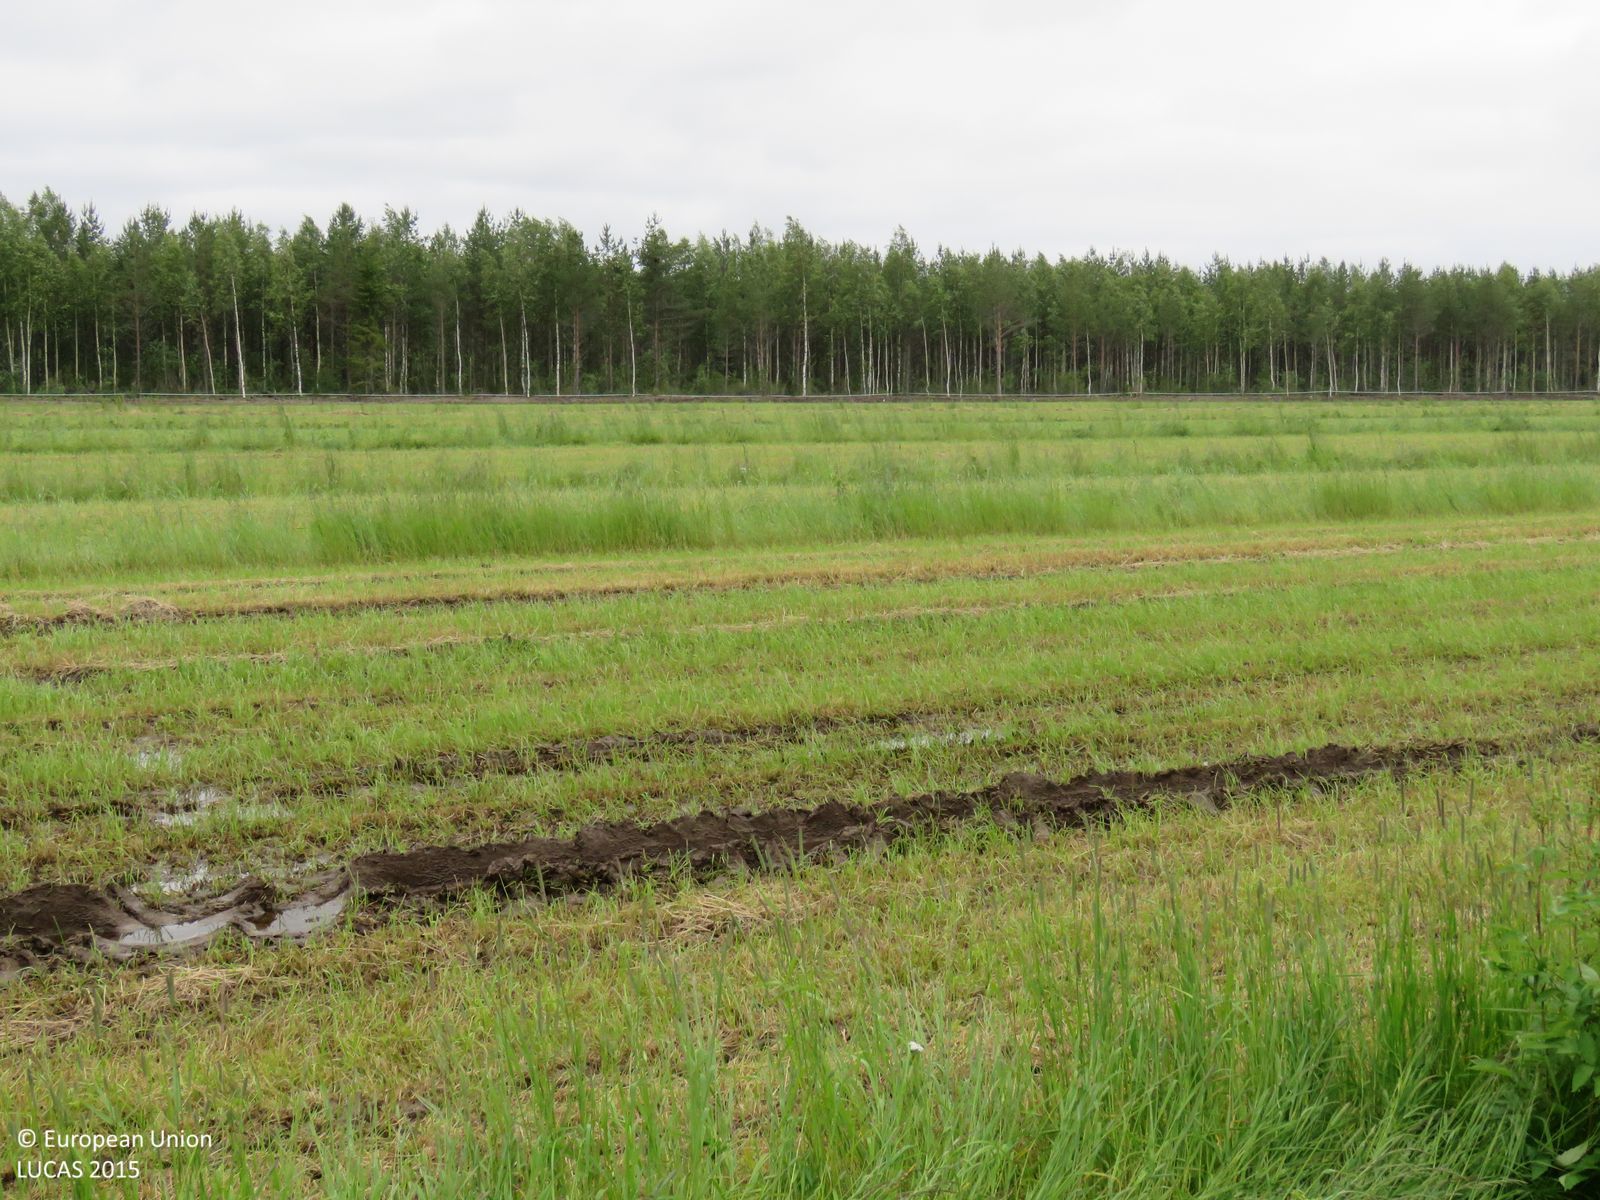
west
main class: Cropland
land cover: Temporary grasslands
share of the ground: > 75 %
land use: Agriculture (excluding fallow land and kitchen gardens)
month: July
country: FI
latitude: 64.4072
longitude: 26.4004
